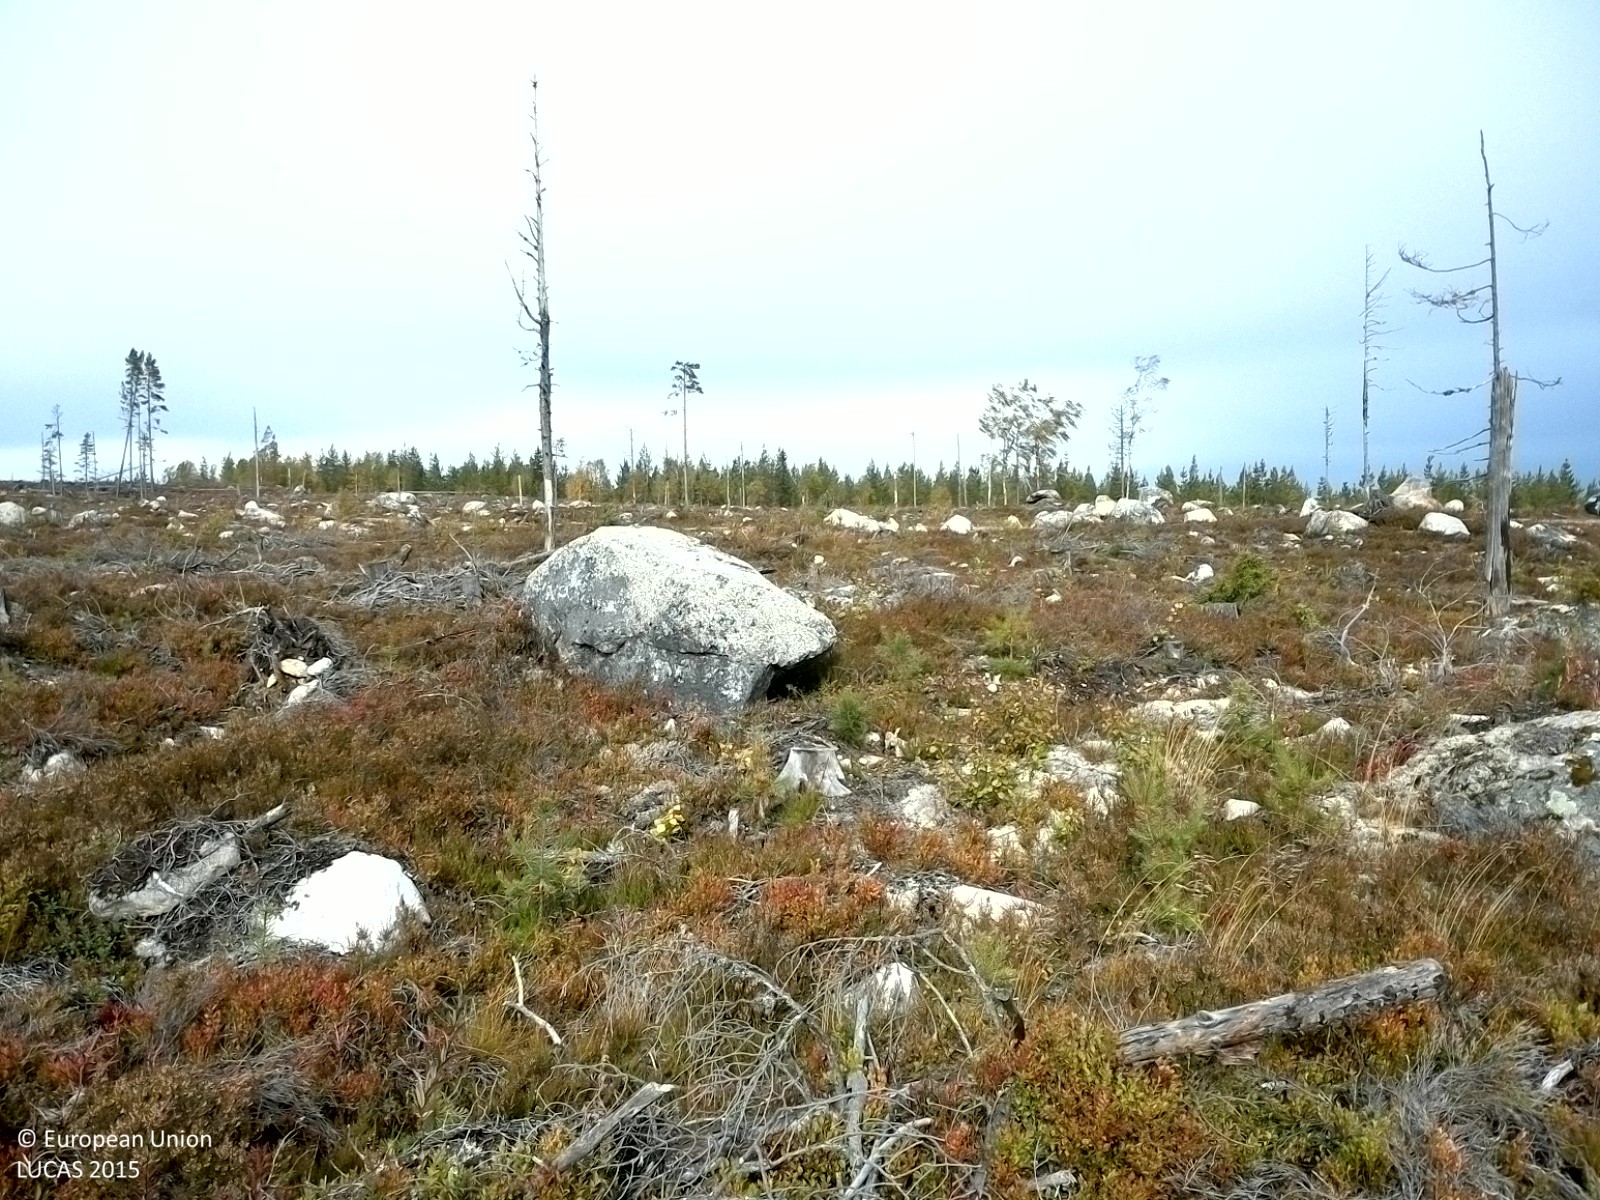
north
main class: Shrubland
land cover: Shrubland with sparse tree cover
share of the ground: > 75 %
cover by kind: shrubs 70 %, unconsolidated bare surface 15 %, coniferous forest trees 5 %
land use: Forestry
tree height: < 5 m
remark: Clear cut
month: September
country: SE
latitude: 62.3110
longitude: 15.5555
